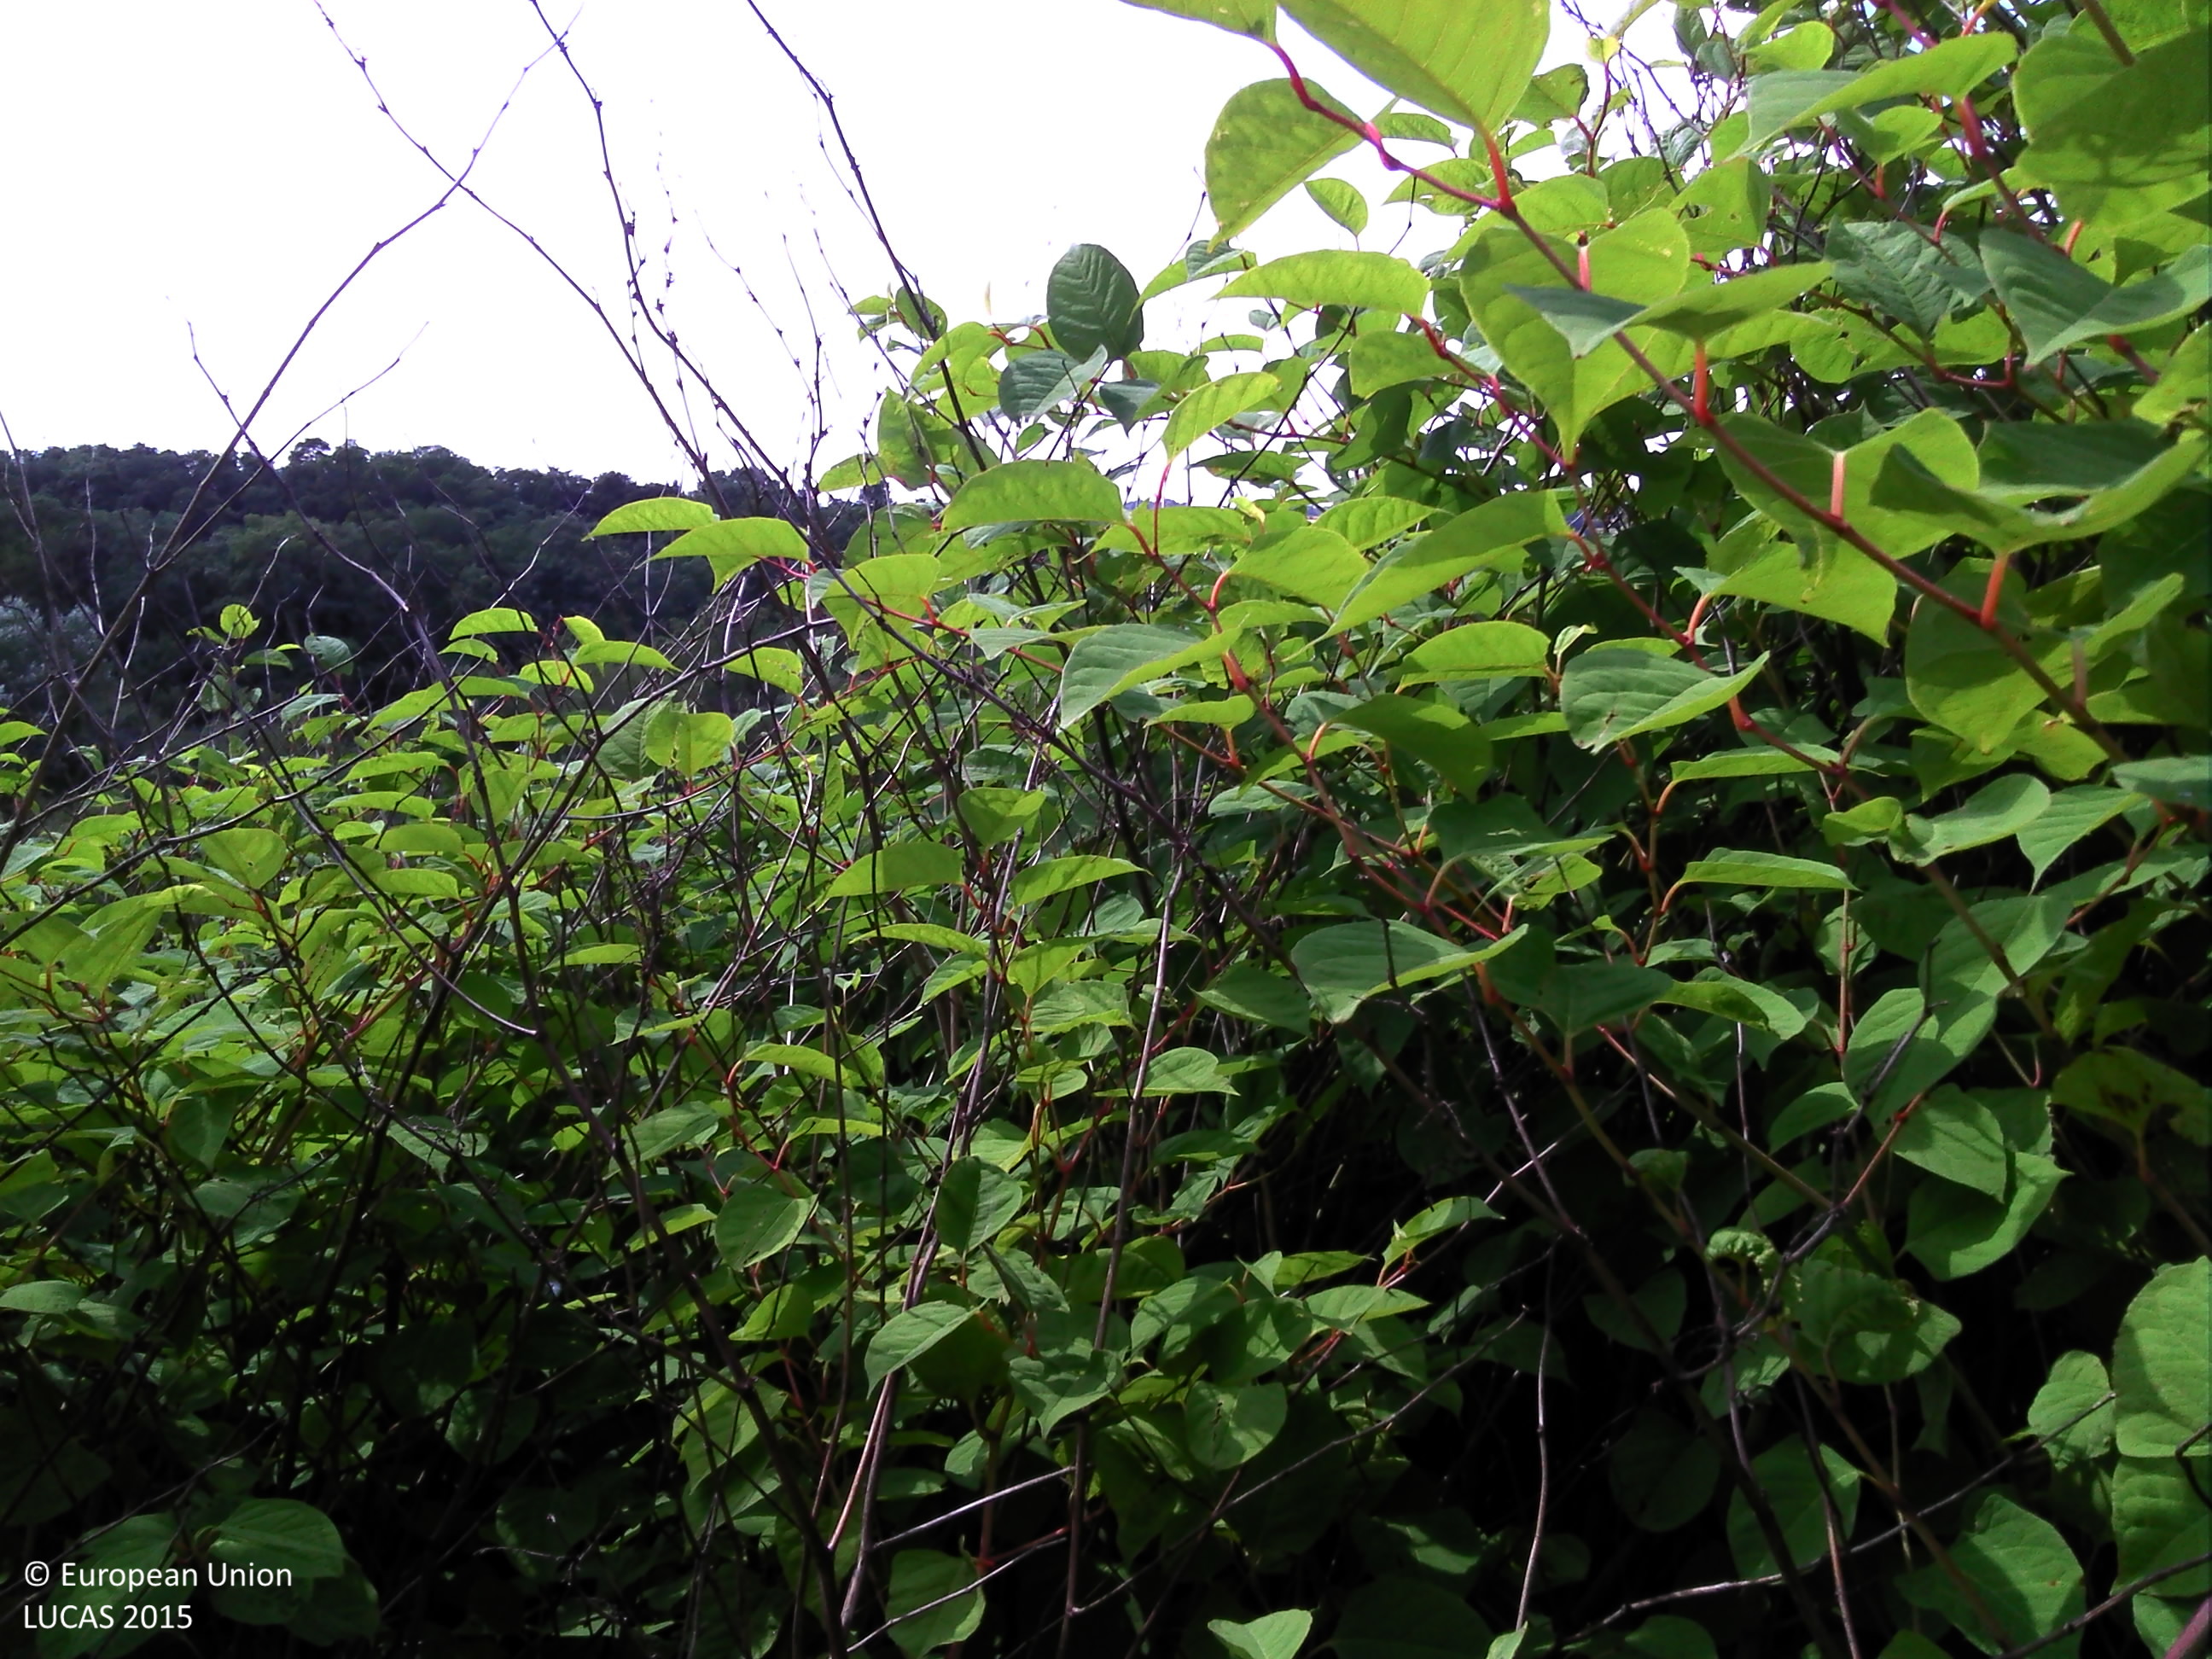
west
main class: Shrubland
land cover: Shrubland with sparse tree cover
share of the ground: > 75 %
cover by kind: shrubs 95 %, broadleaved forest trees 5 %
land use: Semi-natural and natural areas not in use
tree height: > 5 m
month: July
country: BE
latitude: 50.6353
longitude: 5.4879
